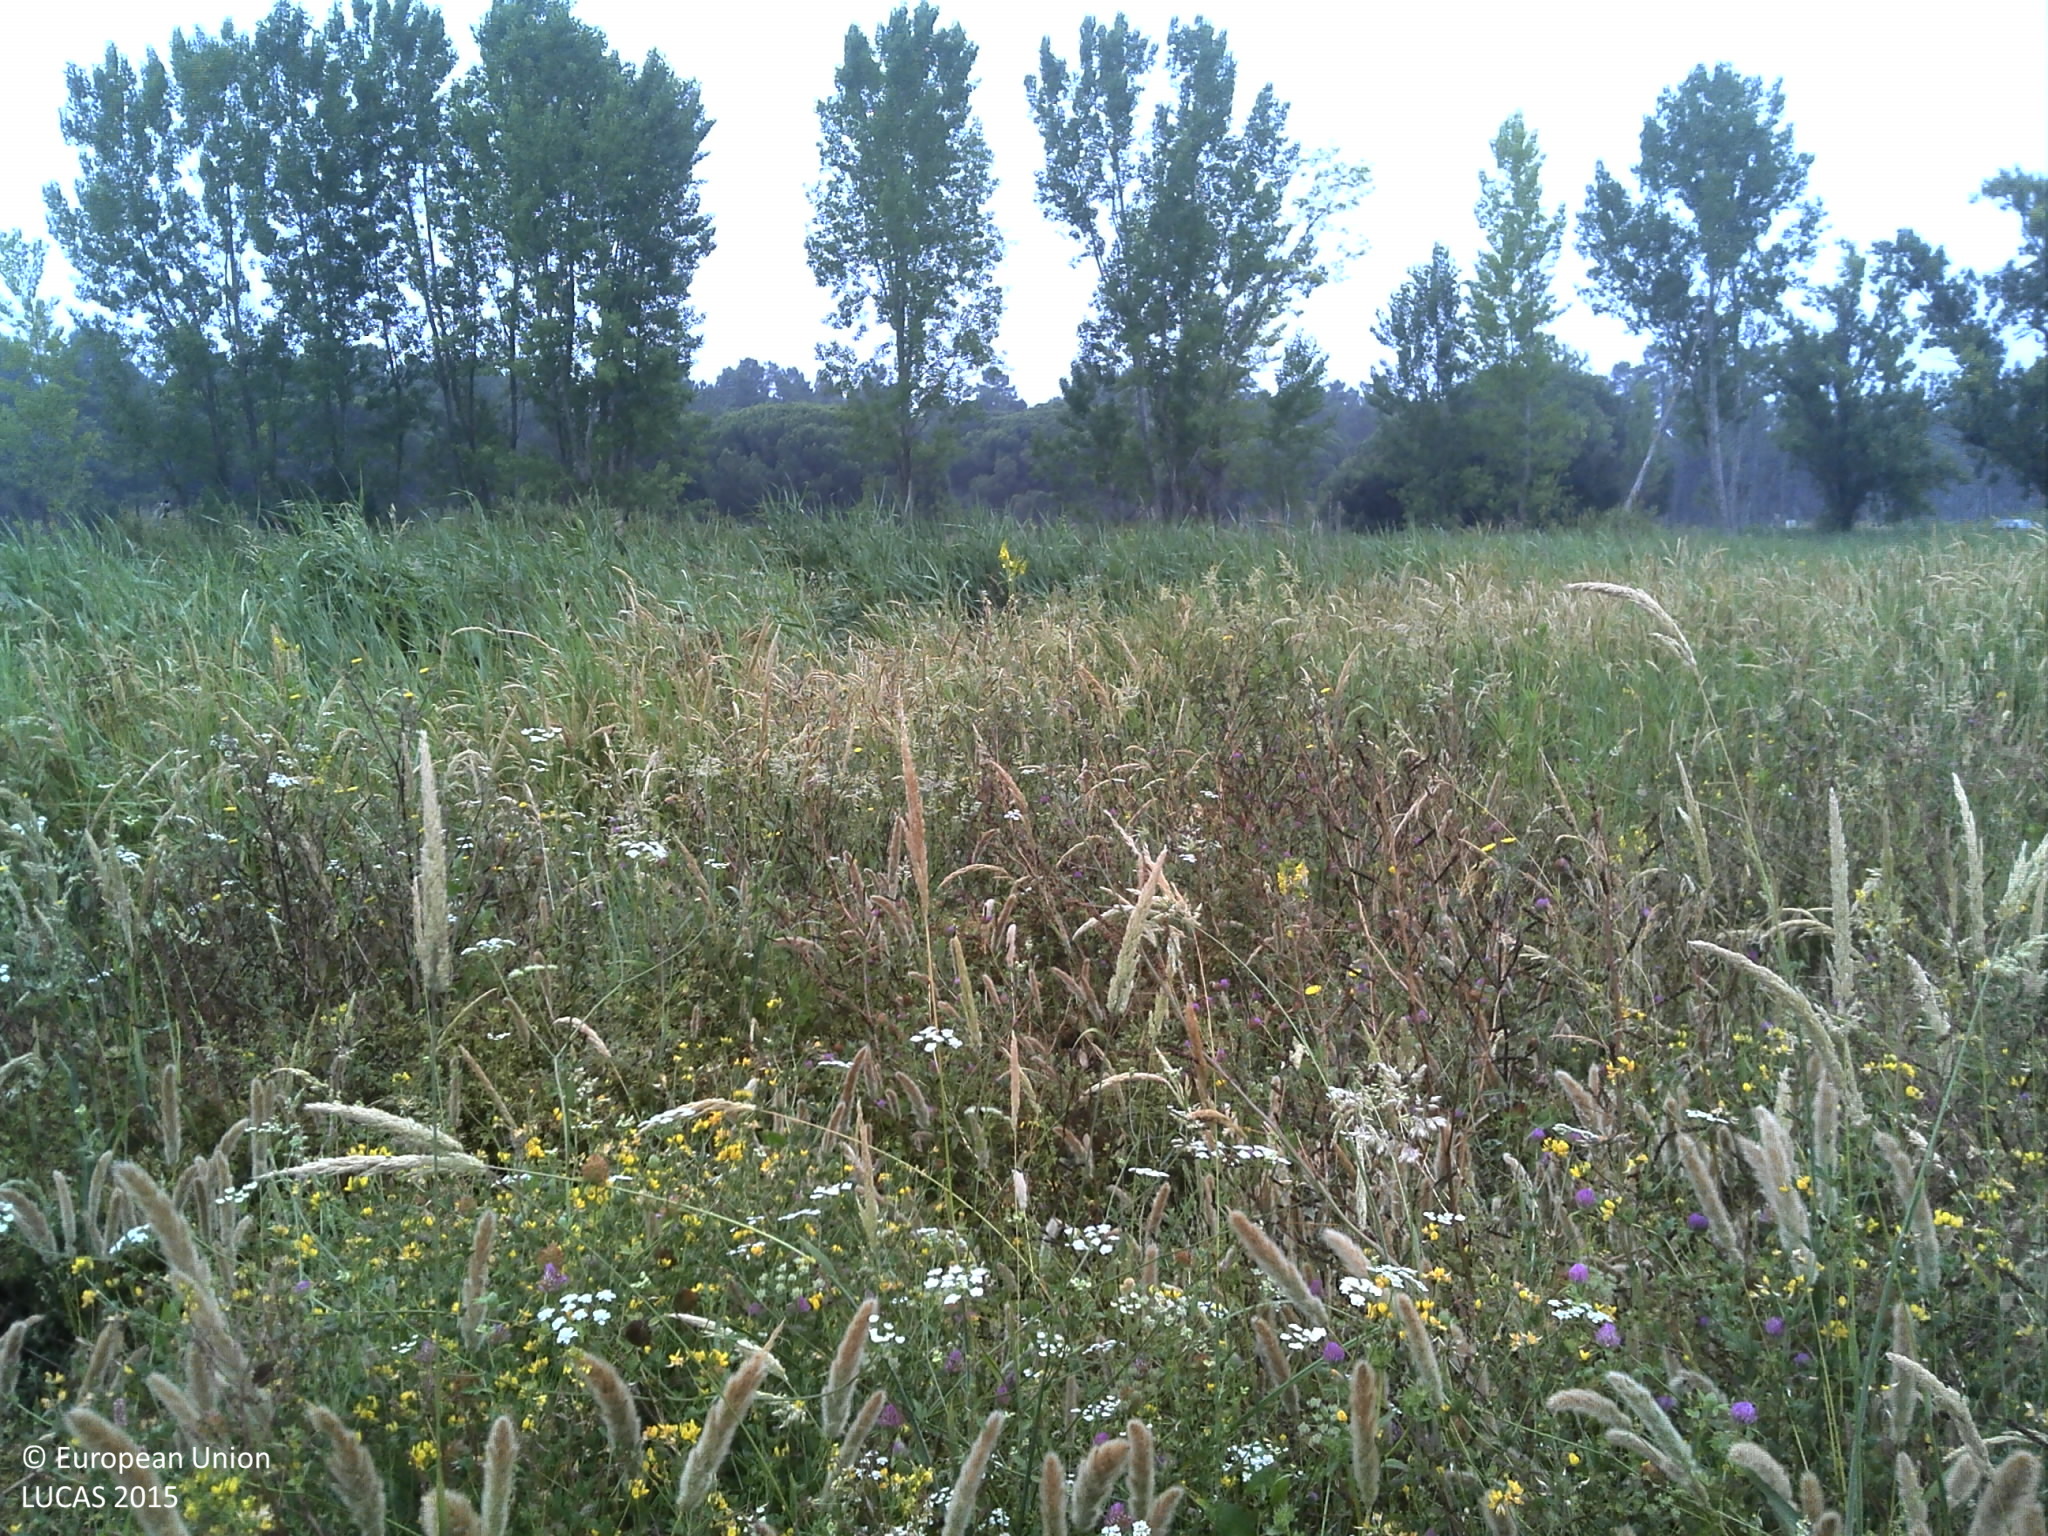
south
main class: Grassland
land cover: Spontaneously vegetated surfaces
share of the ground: > 75 %
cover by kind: herbaceous plants 95 %, unconsolidated bare surface 5 %
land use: Fallow land
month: June
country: PT
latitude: 38.5327
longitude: -9.1252
